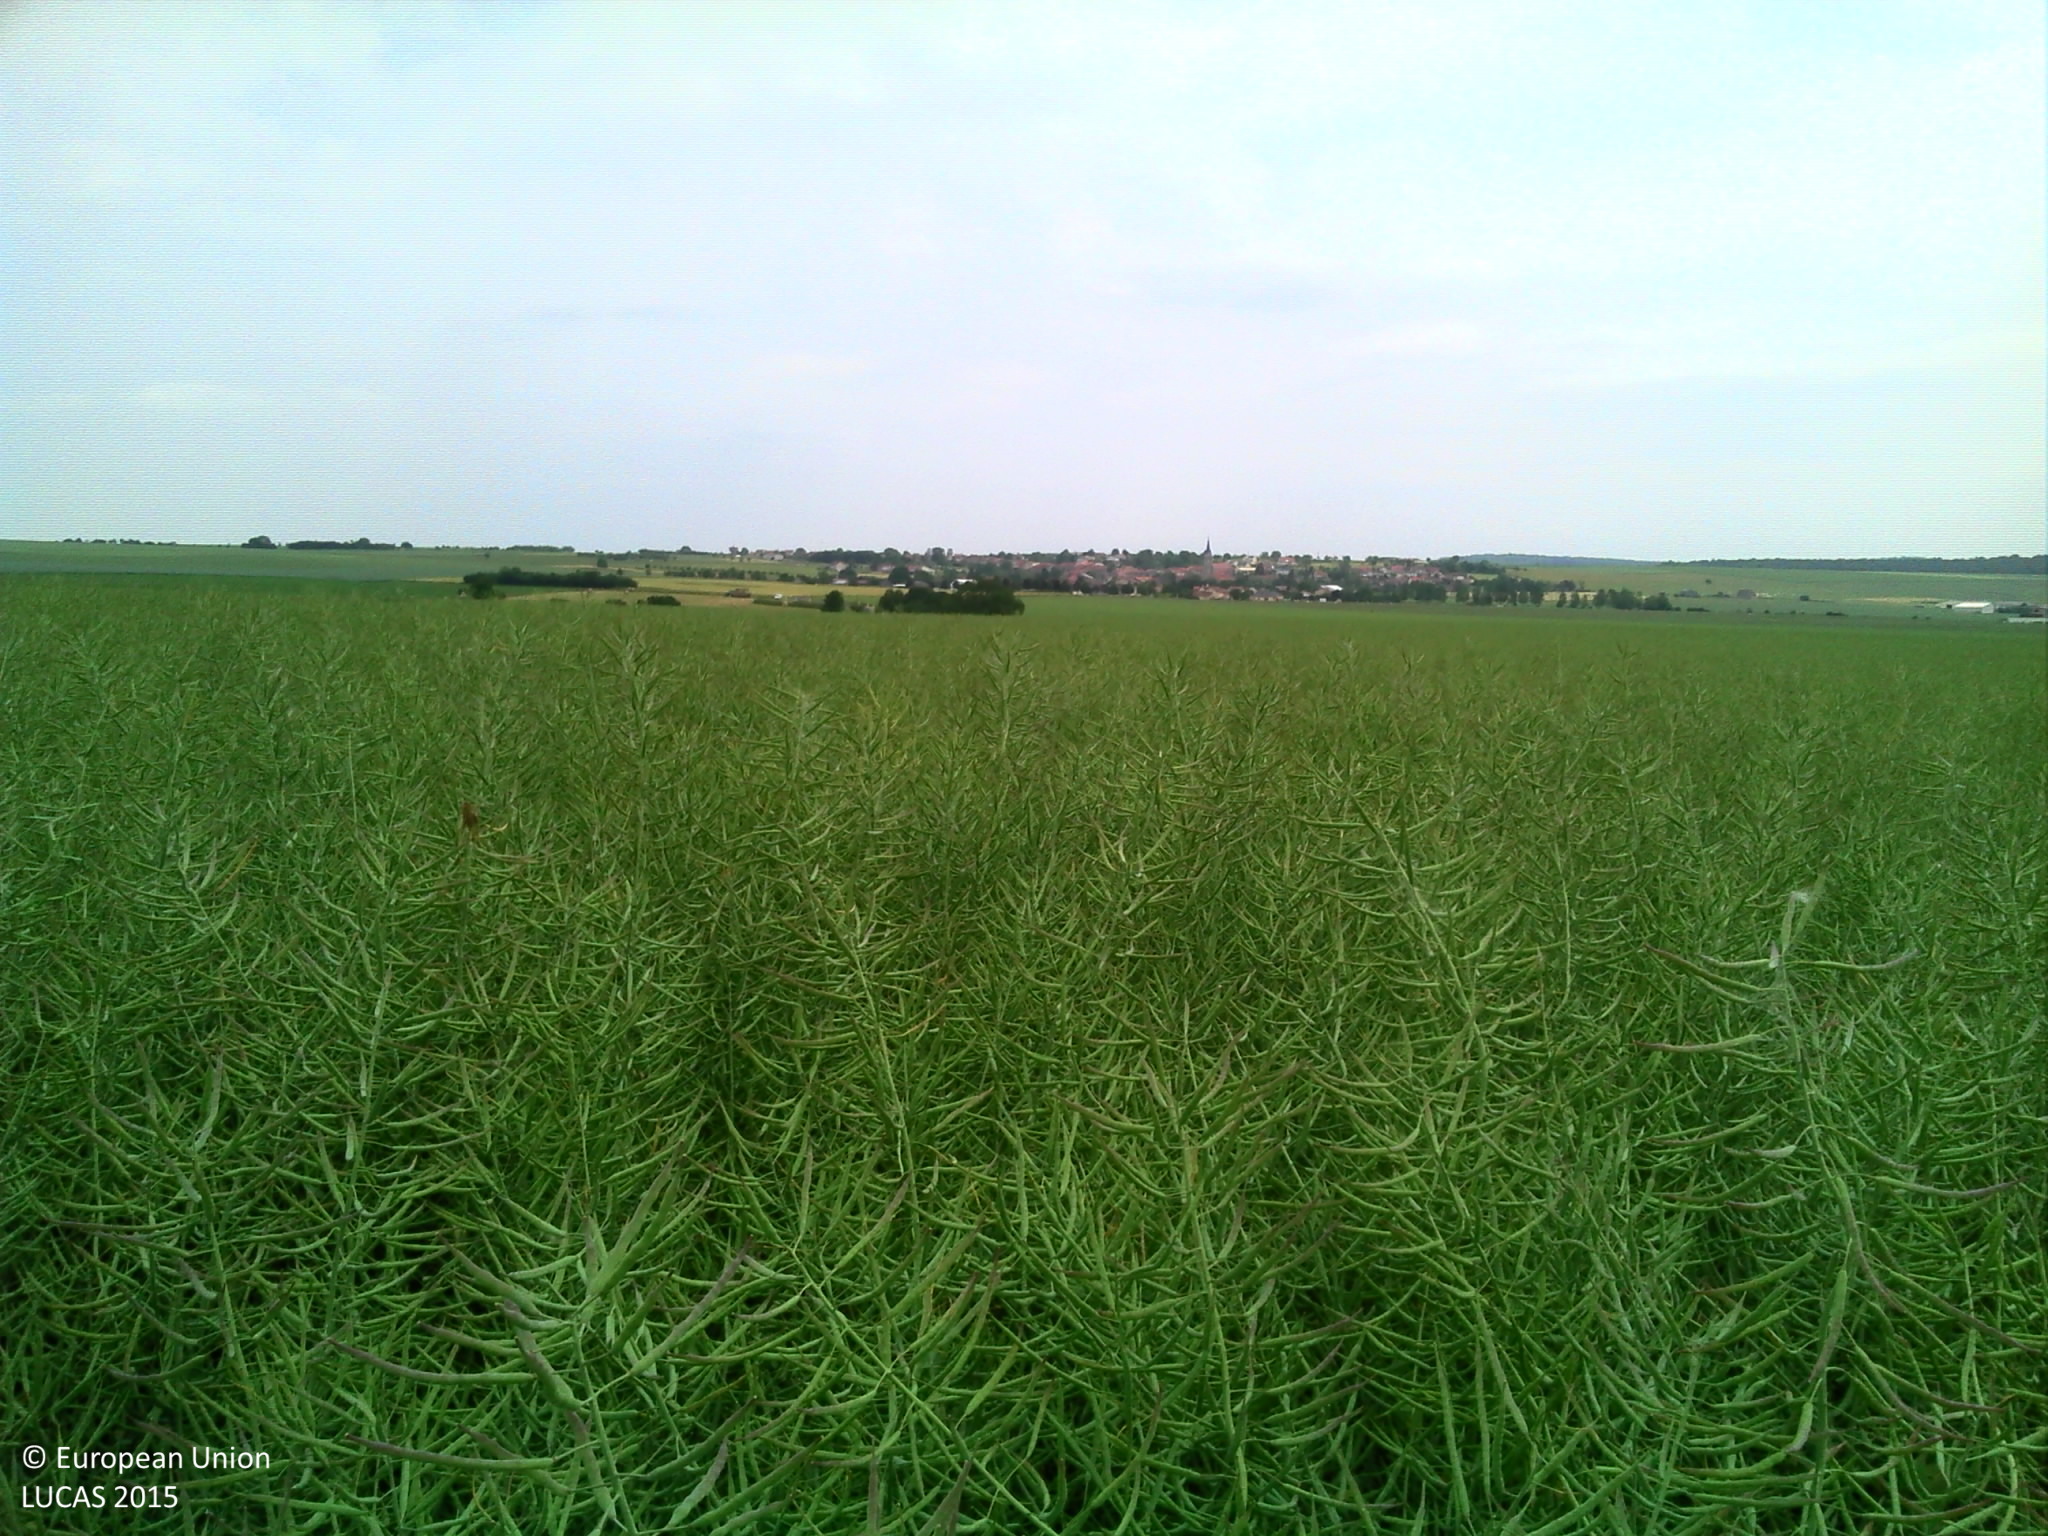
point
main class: Cropland
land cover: Rape and turnip rape
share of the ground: > 75 %
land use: Agriculture (excluding fallow land and kitchen gardens)
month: June
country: FR
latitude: 48.5182
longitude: 6.1958
